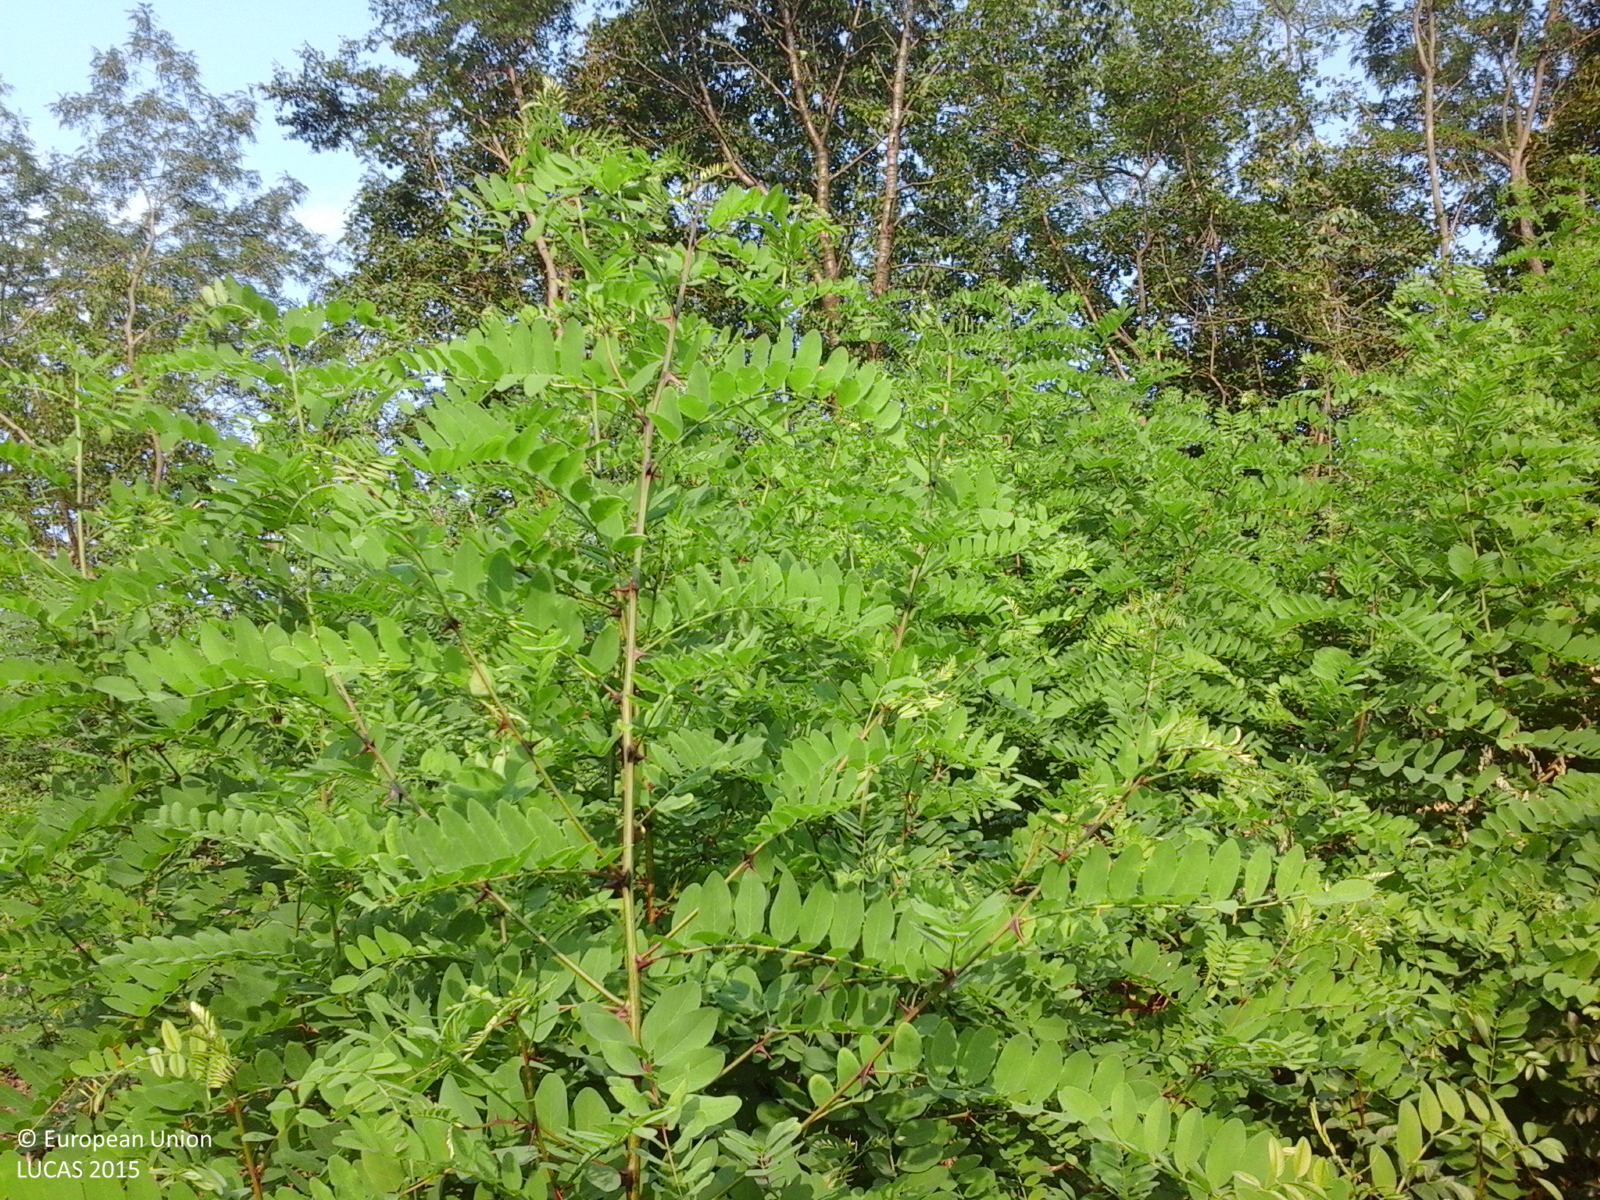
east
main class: Shrubland
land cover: Shrubland with sparse tree cover
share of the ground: > 75 %
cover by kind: shrubs 95 %, broadleaved forest trees 5 %
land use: Forestry
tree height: < 5 m
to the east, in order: Shrubland with sparse tree cover; Tracks; Broadleaved woodland; Grassland without tree/shrub cover; Broadleaved woodland
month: July
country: RO
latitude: 44.8644
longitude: 24.4893
